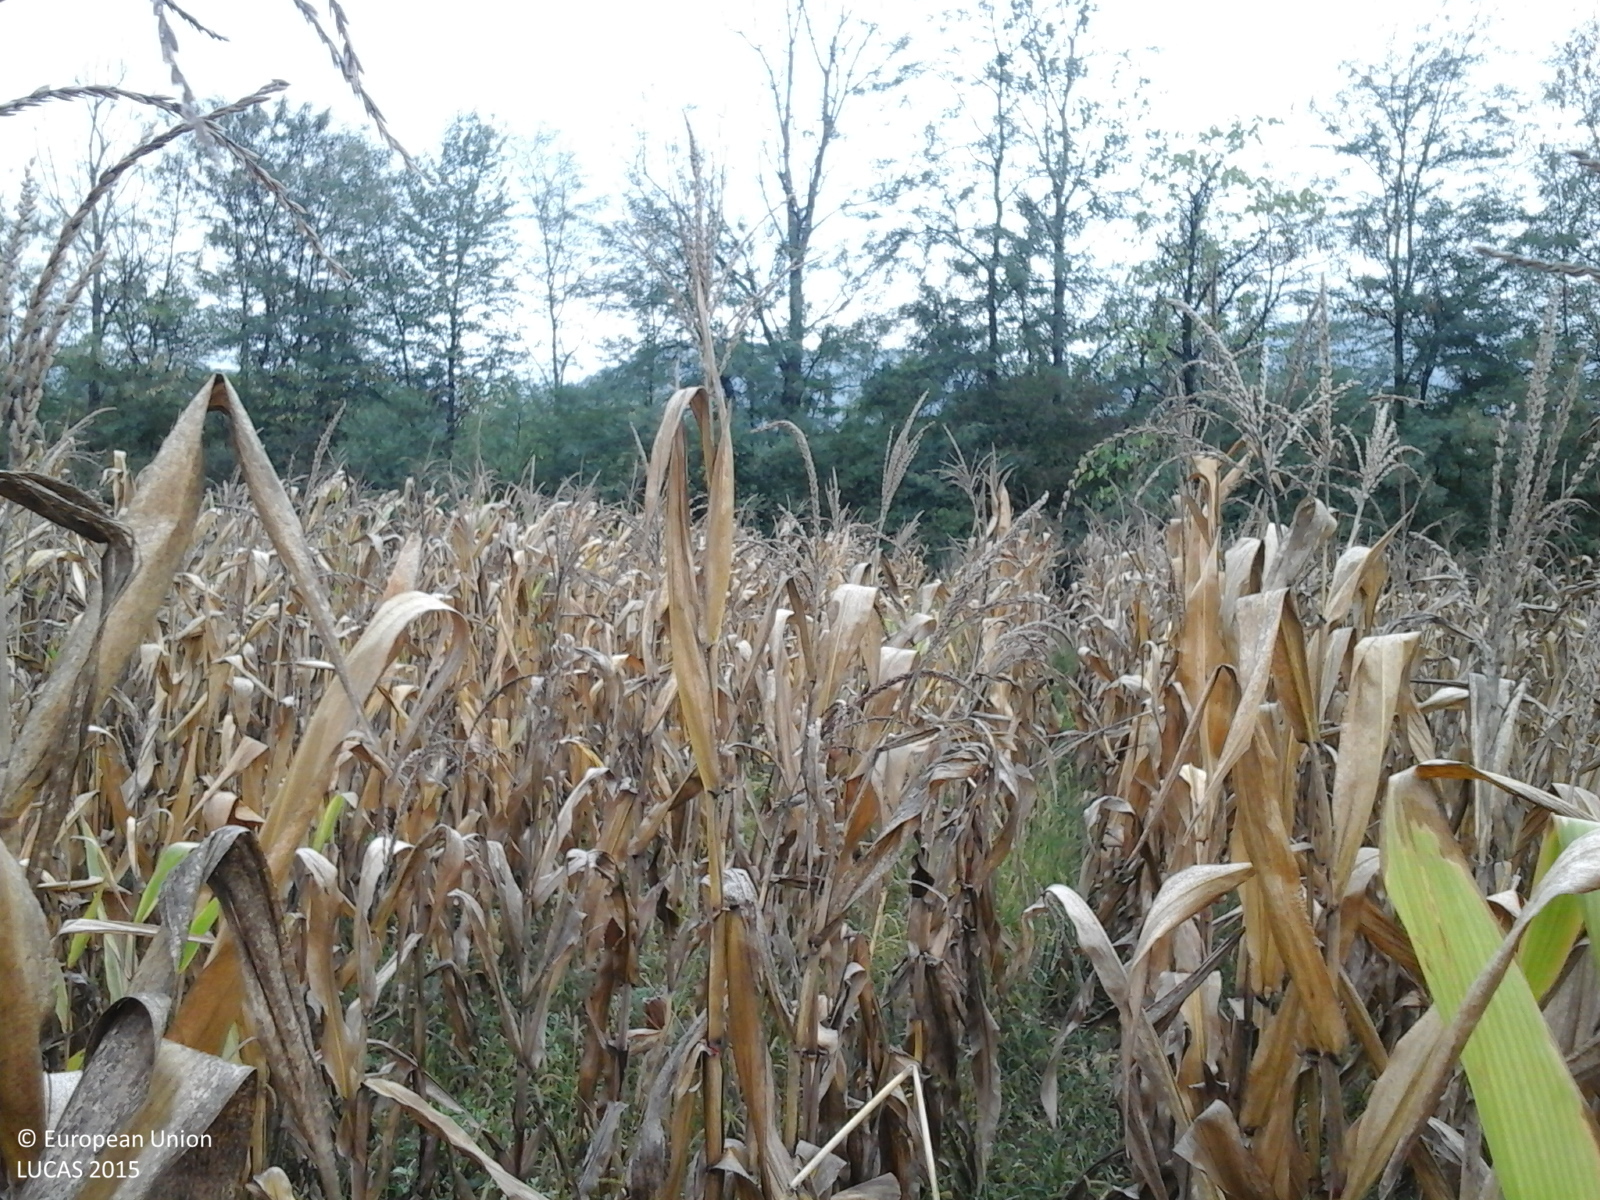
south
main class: Cropland
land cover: Maize
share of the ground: > 75 %
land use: Agriculture (excluding fallow land and kitchen gardens)
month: September
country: RO
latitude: 45.9179
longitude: 22.8565
